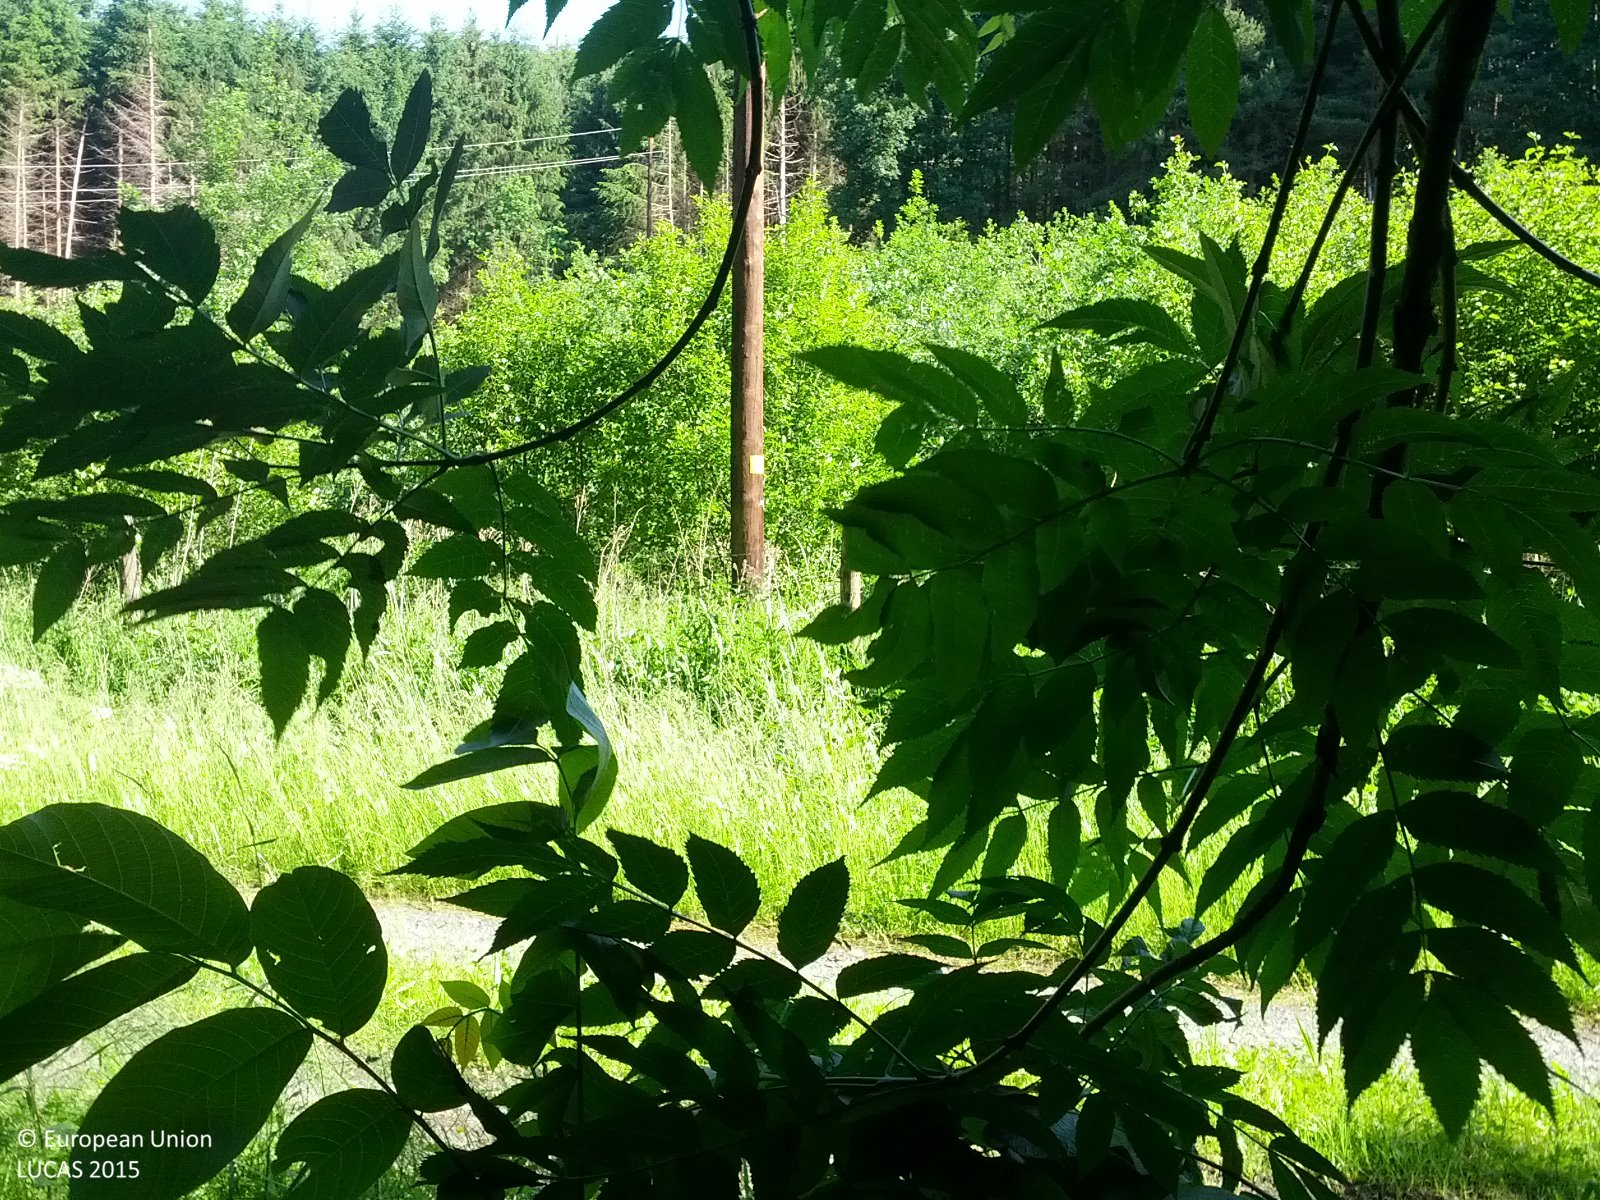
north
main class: Woodland
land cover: Spruce dominated coniferous woodland
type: hemiboreal forest and nemoral coniferous forest and mixed broadleaved-coniferous forest
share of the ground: > 75 %
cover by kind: coniferous forest trees 85 %, herbaceous plants 10 %, broadleaved forest trees 5 %
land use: Forestry
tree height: > 5 m
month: June
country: AT
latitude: 47.2025
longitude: 16.1669
